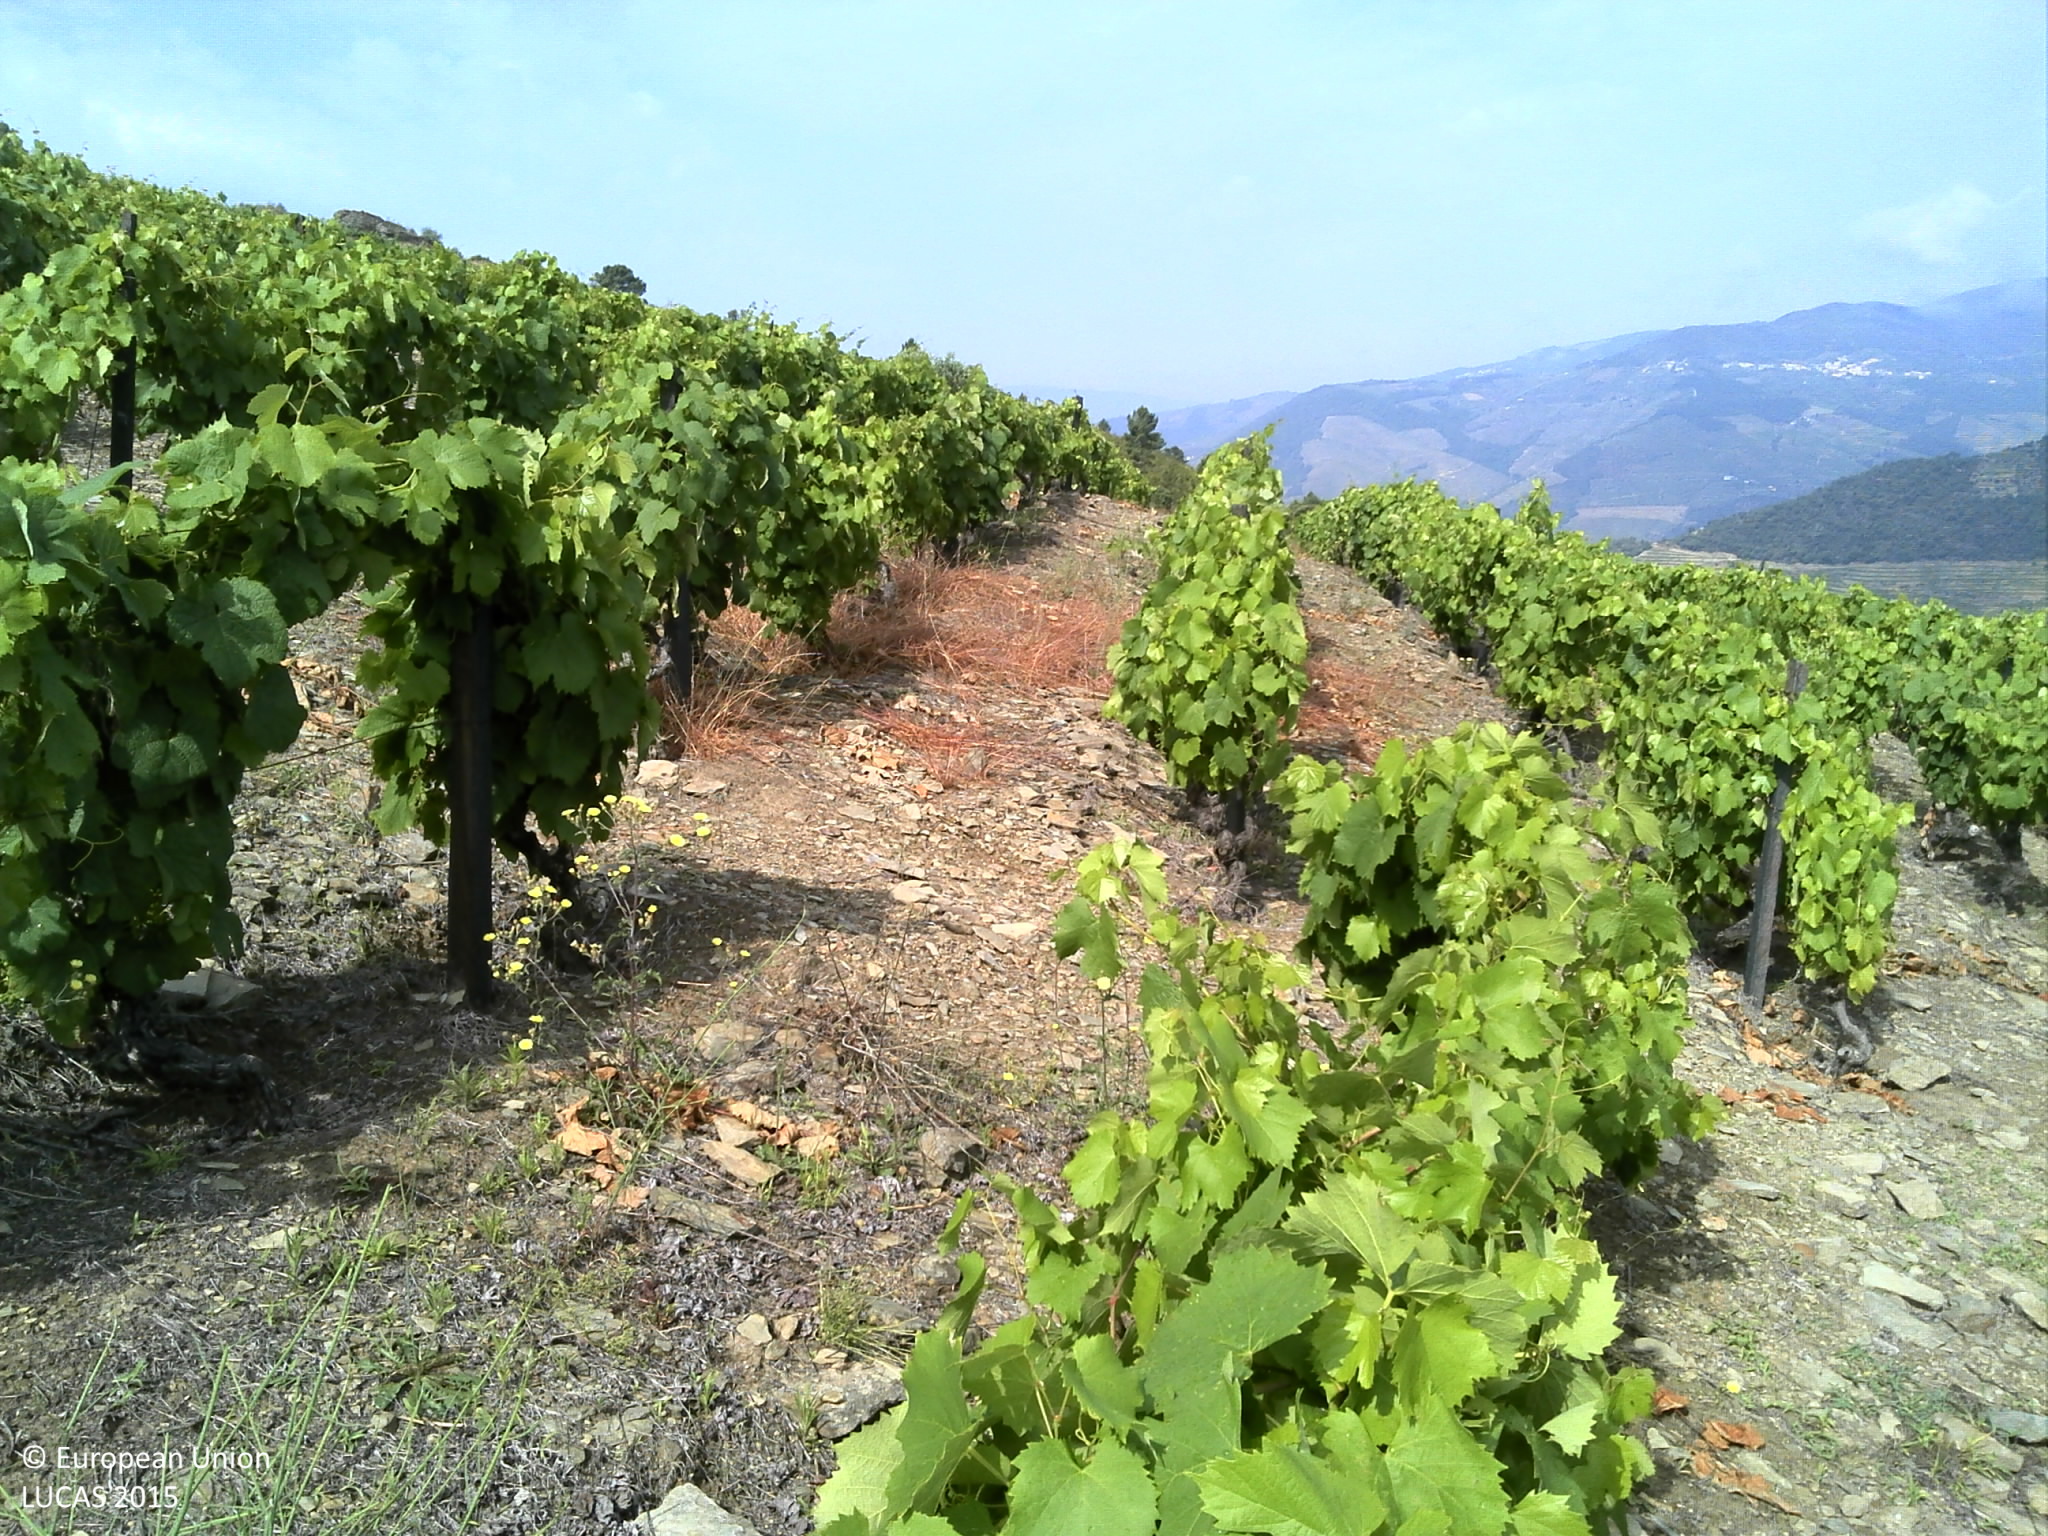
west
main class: Cropland
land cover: Vineyards
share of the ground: 10 - 25 %
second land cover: Spontaneously vegetated surfaces
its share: < 10 %
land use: Agriculture (excluding fallow land and kitchen gardens)
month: June
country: PT
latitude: 41.1912
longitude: -7.4940
